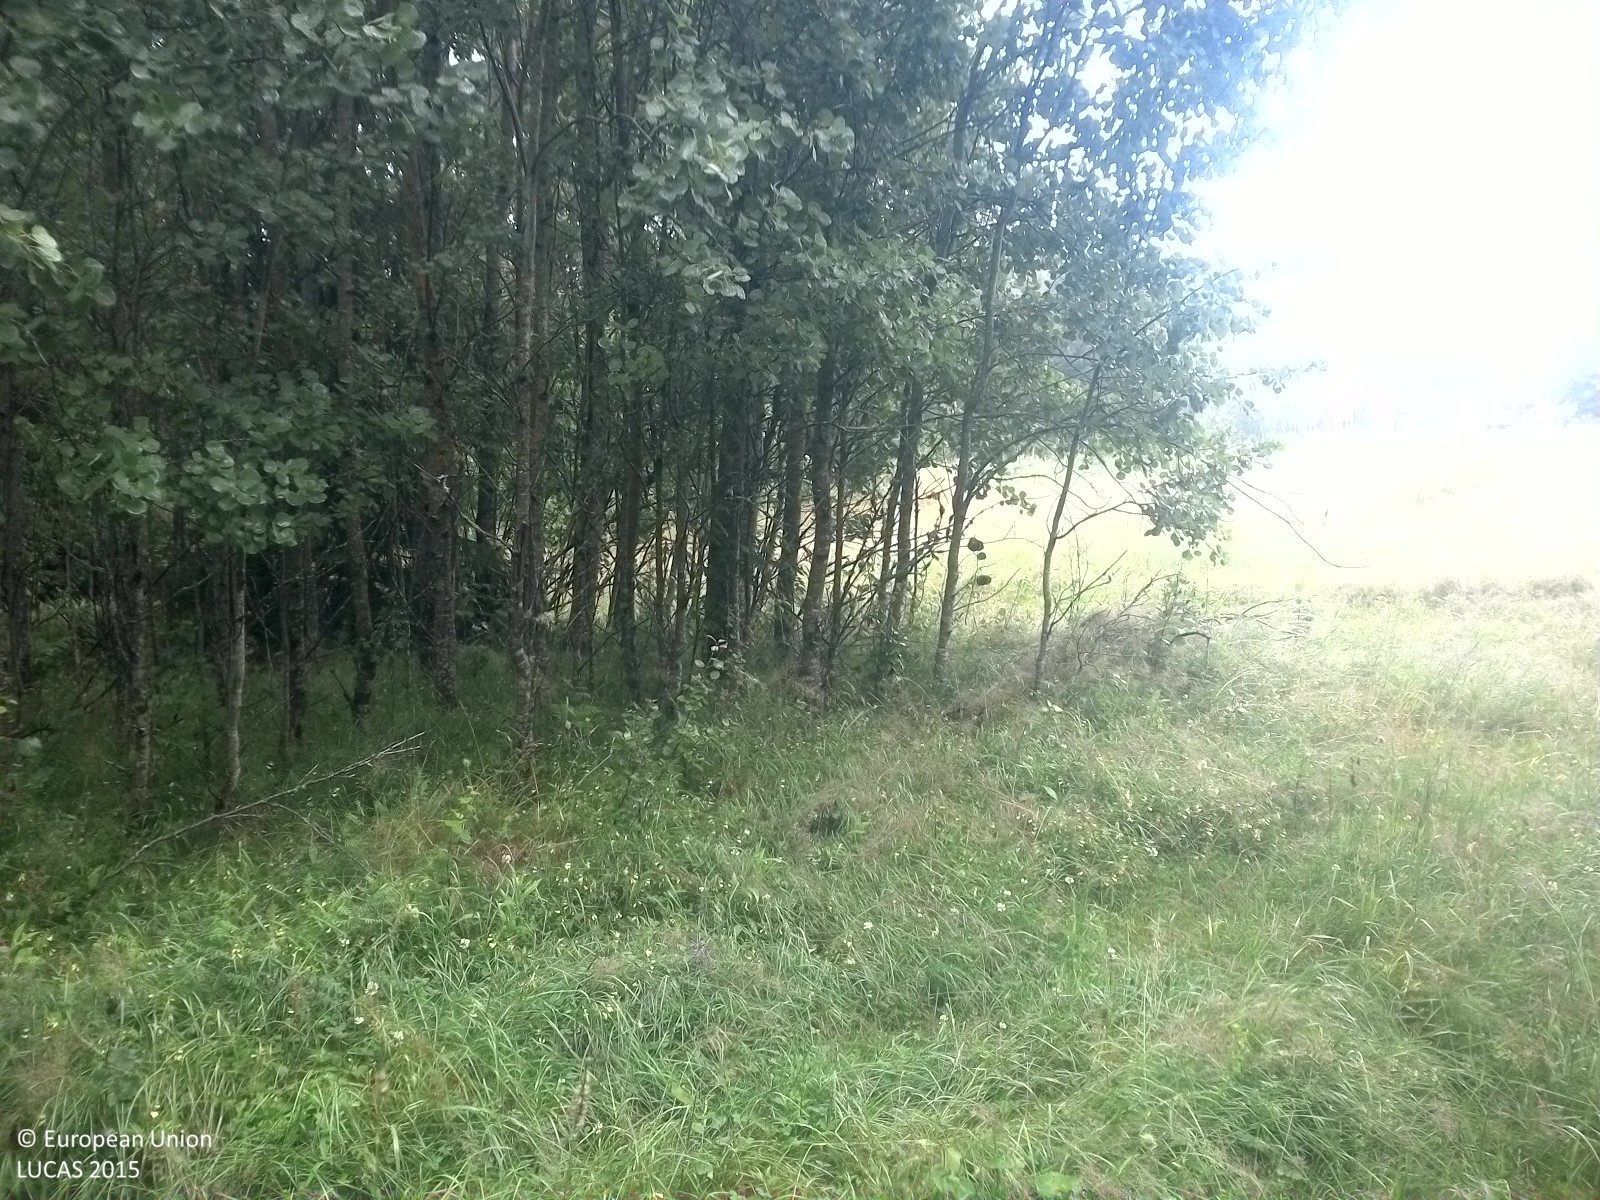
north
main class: Grassland
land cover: Grassland without tree/shrub cover
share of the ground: > 75 %
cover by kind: herbaceous plants 100 %
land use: Semi-natural and natural areas not in use
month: July
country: SE
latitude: 58.9360
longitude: 15.0487
